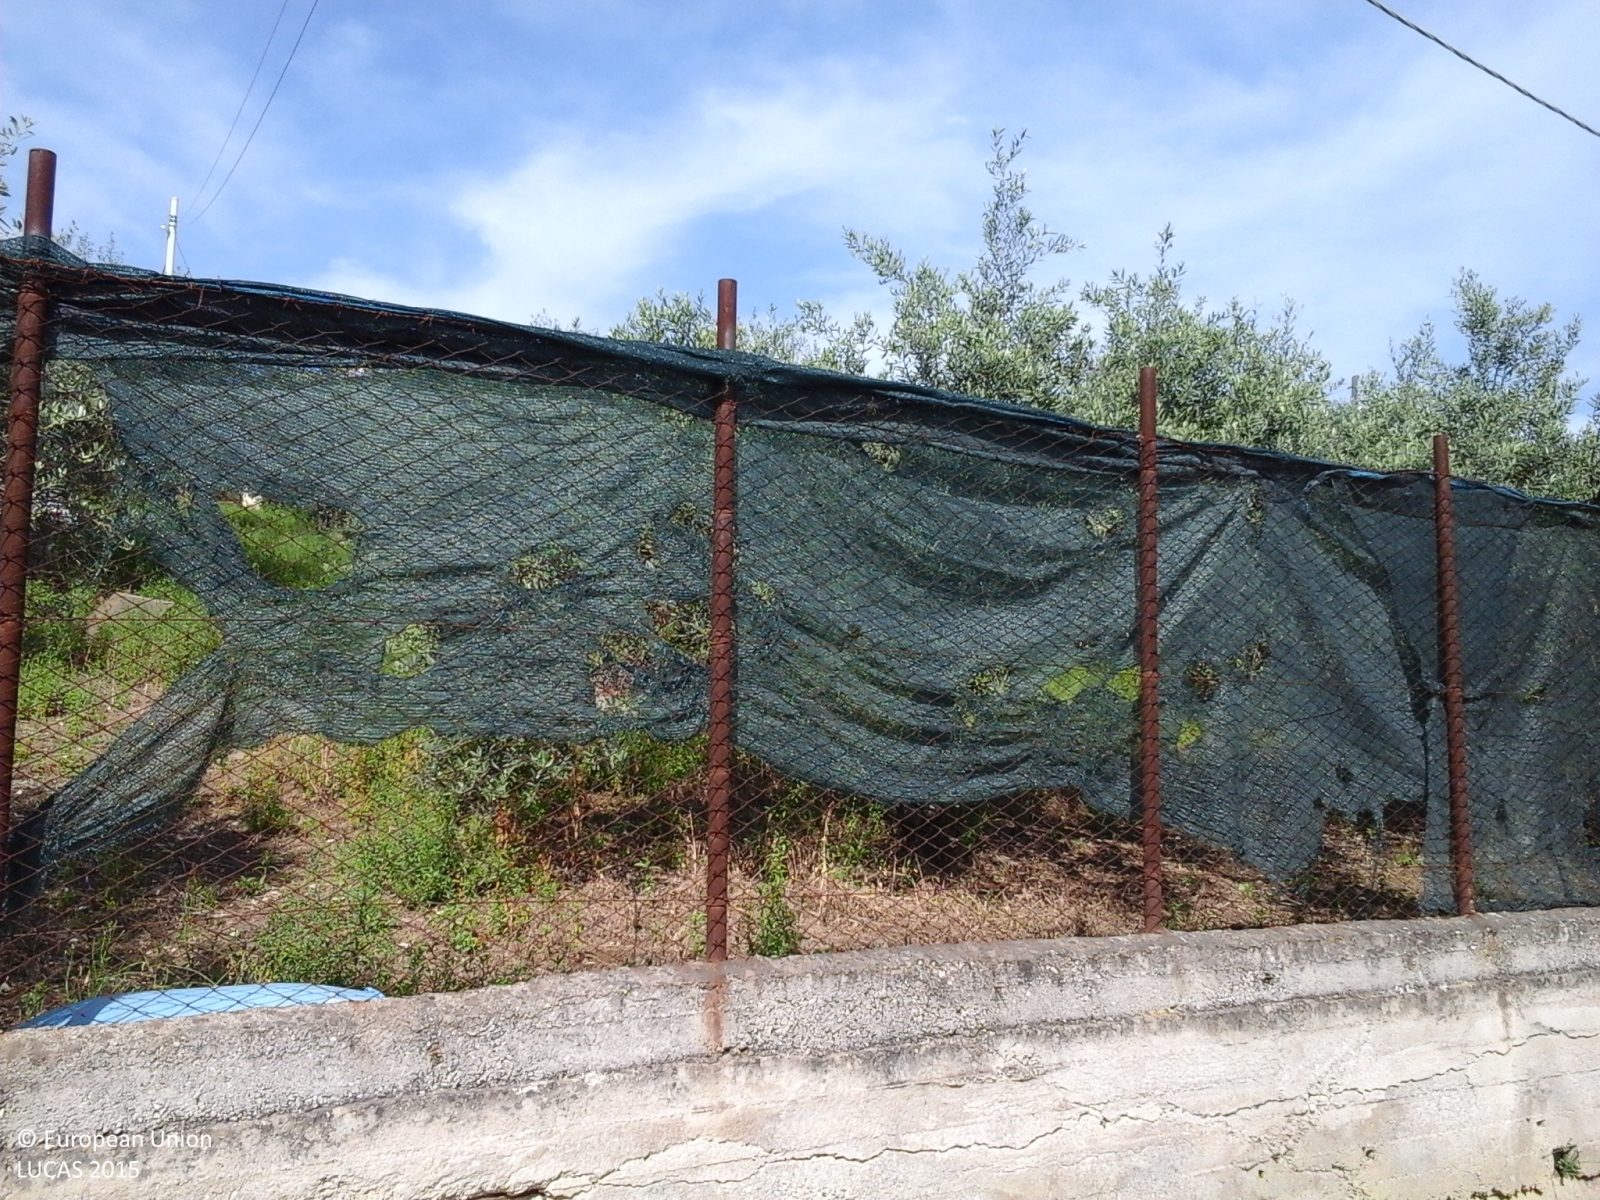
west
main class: Cropland
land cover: Olive groves
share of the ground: 50 - 75 %
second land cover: Spontaneously vegetated surfaces
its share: > 75 %
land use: Agriculture (excluding fallow land and kitchen gardens)
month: May
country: IT
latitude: 38.0466
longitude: 13.4965
